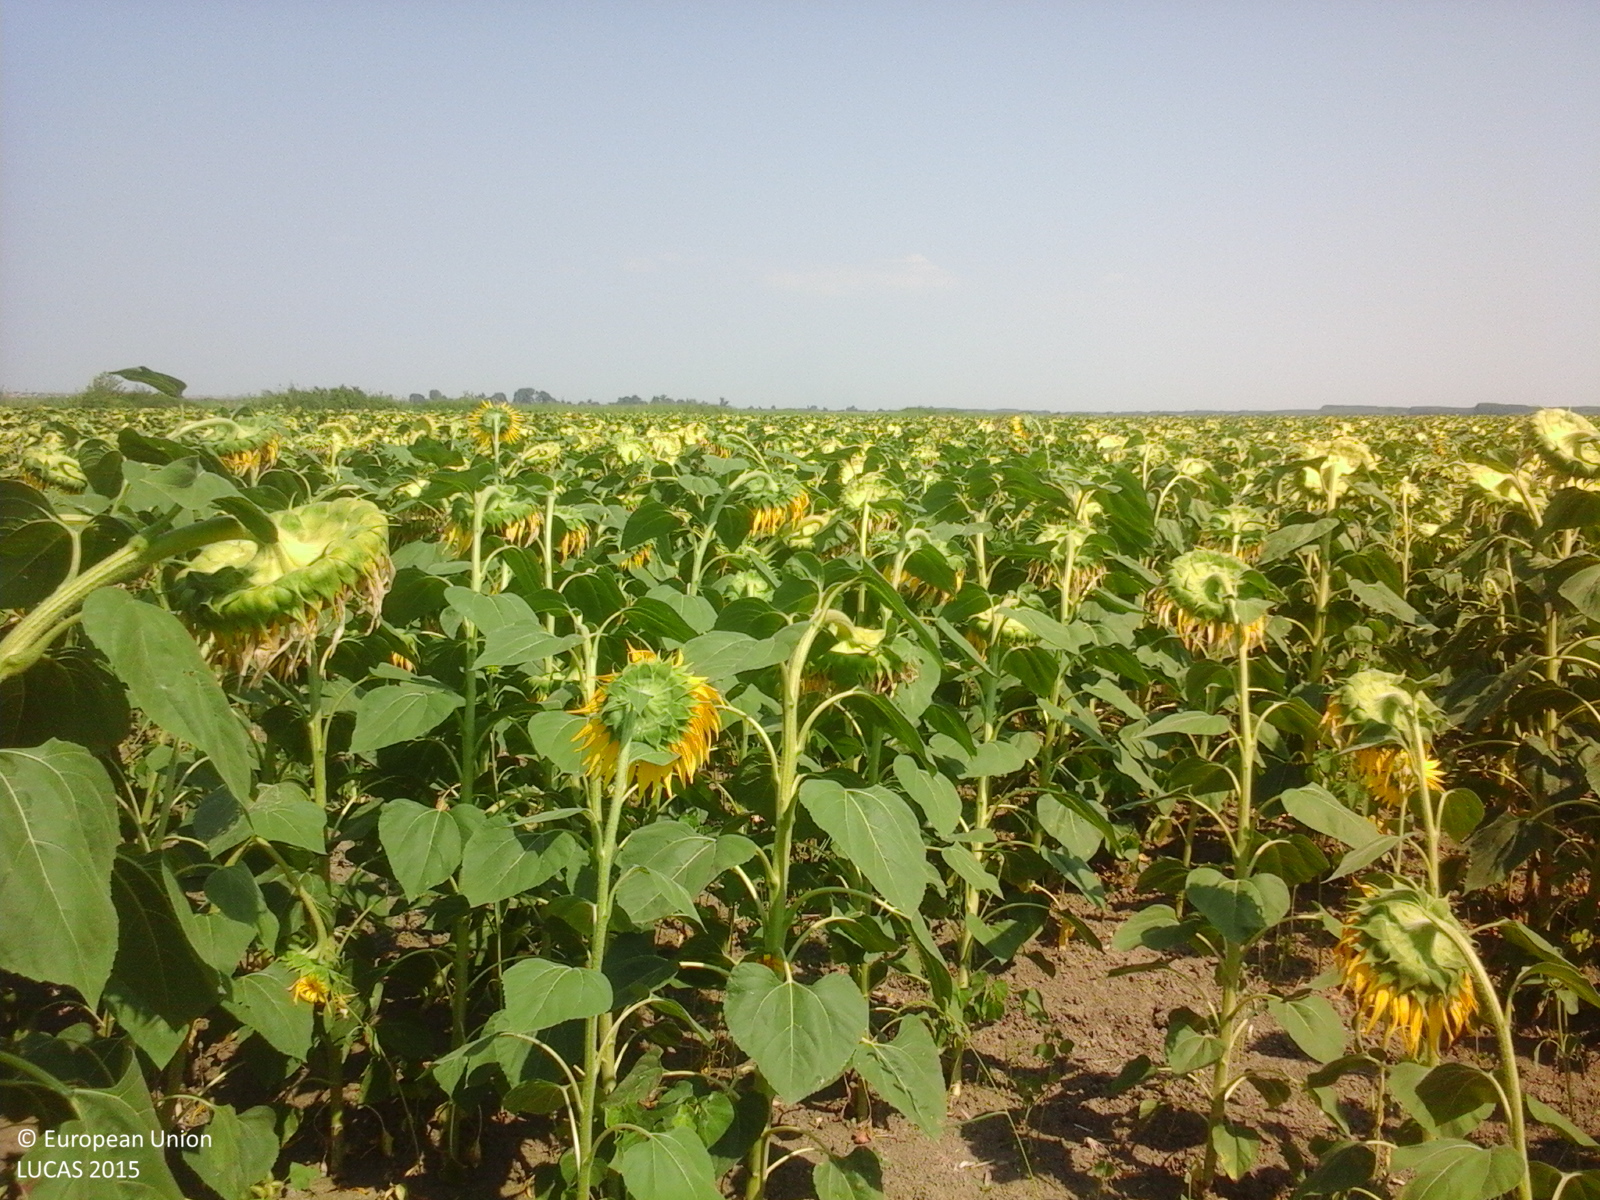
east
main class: Cropland
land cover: Sunflower
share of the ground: > 75 %
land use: Agriculture (excluding fallow land and kitchen gardens)
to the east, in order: Sunflower; Abandoned hedges; Ditches and canals; Abandoned hedges; Maize
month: July
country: RO
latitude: 45.4124
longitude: 27.8082
